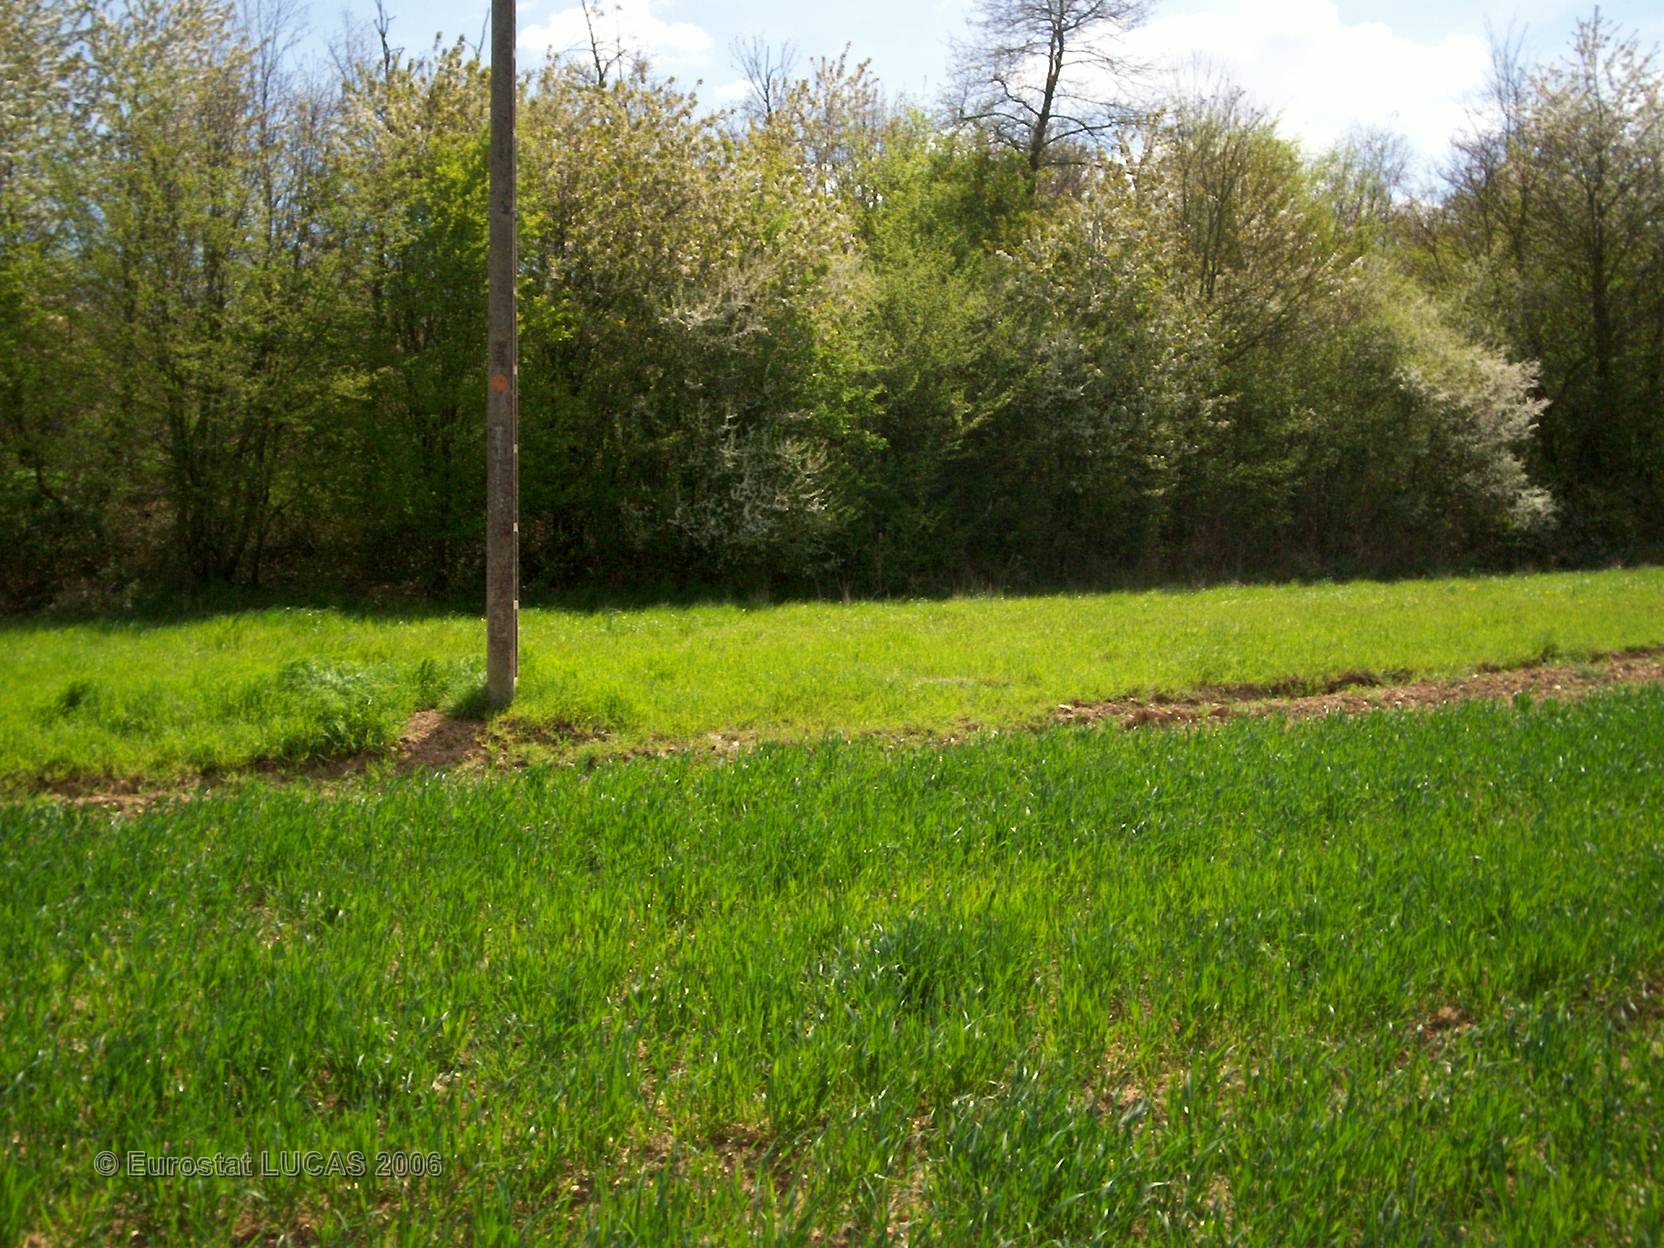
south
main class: Cropland
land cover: Common wheat
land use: Agriculture (excluding fallow land and kitchen gardens)
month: April
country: FR
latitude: 48.9438
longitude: 1.0358
